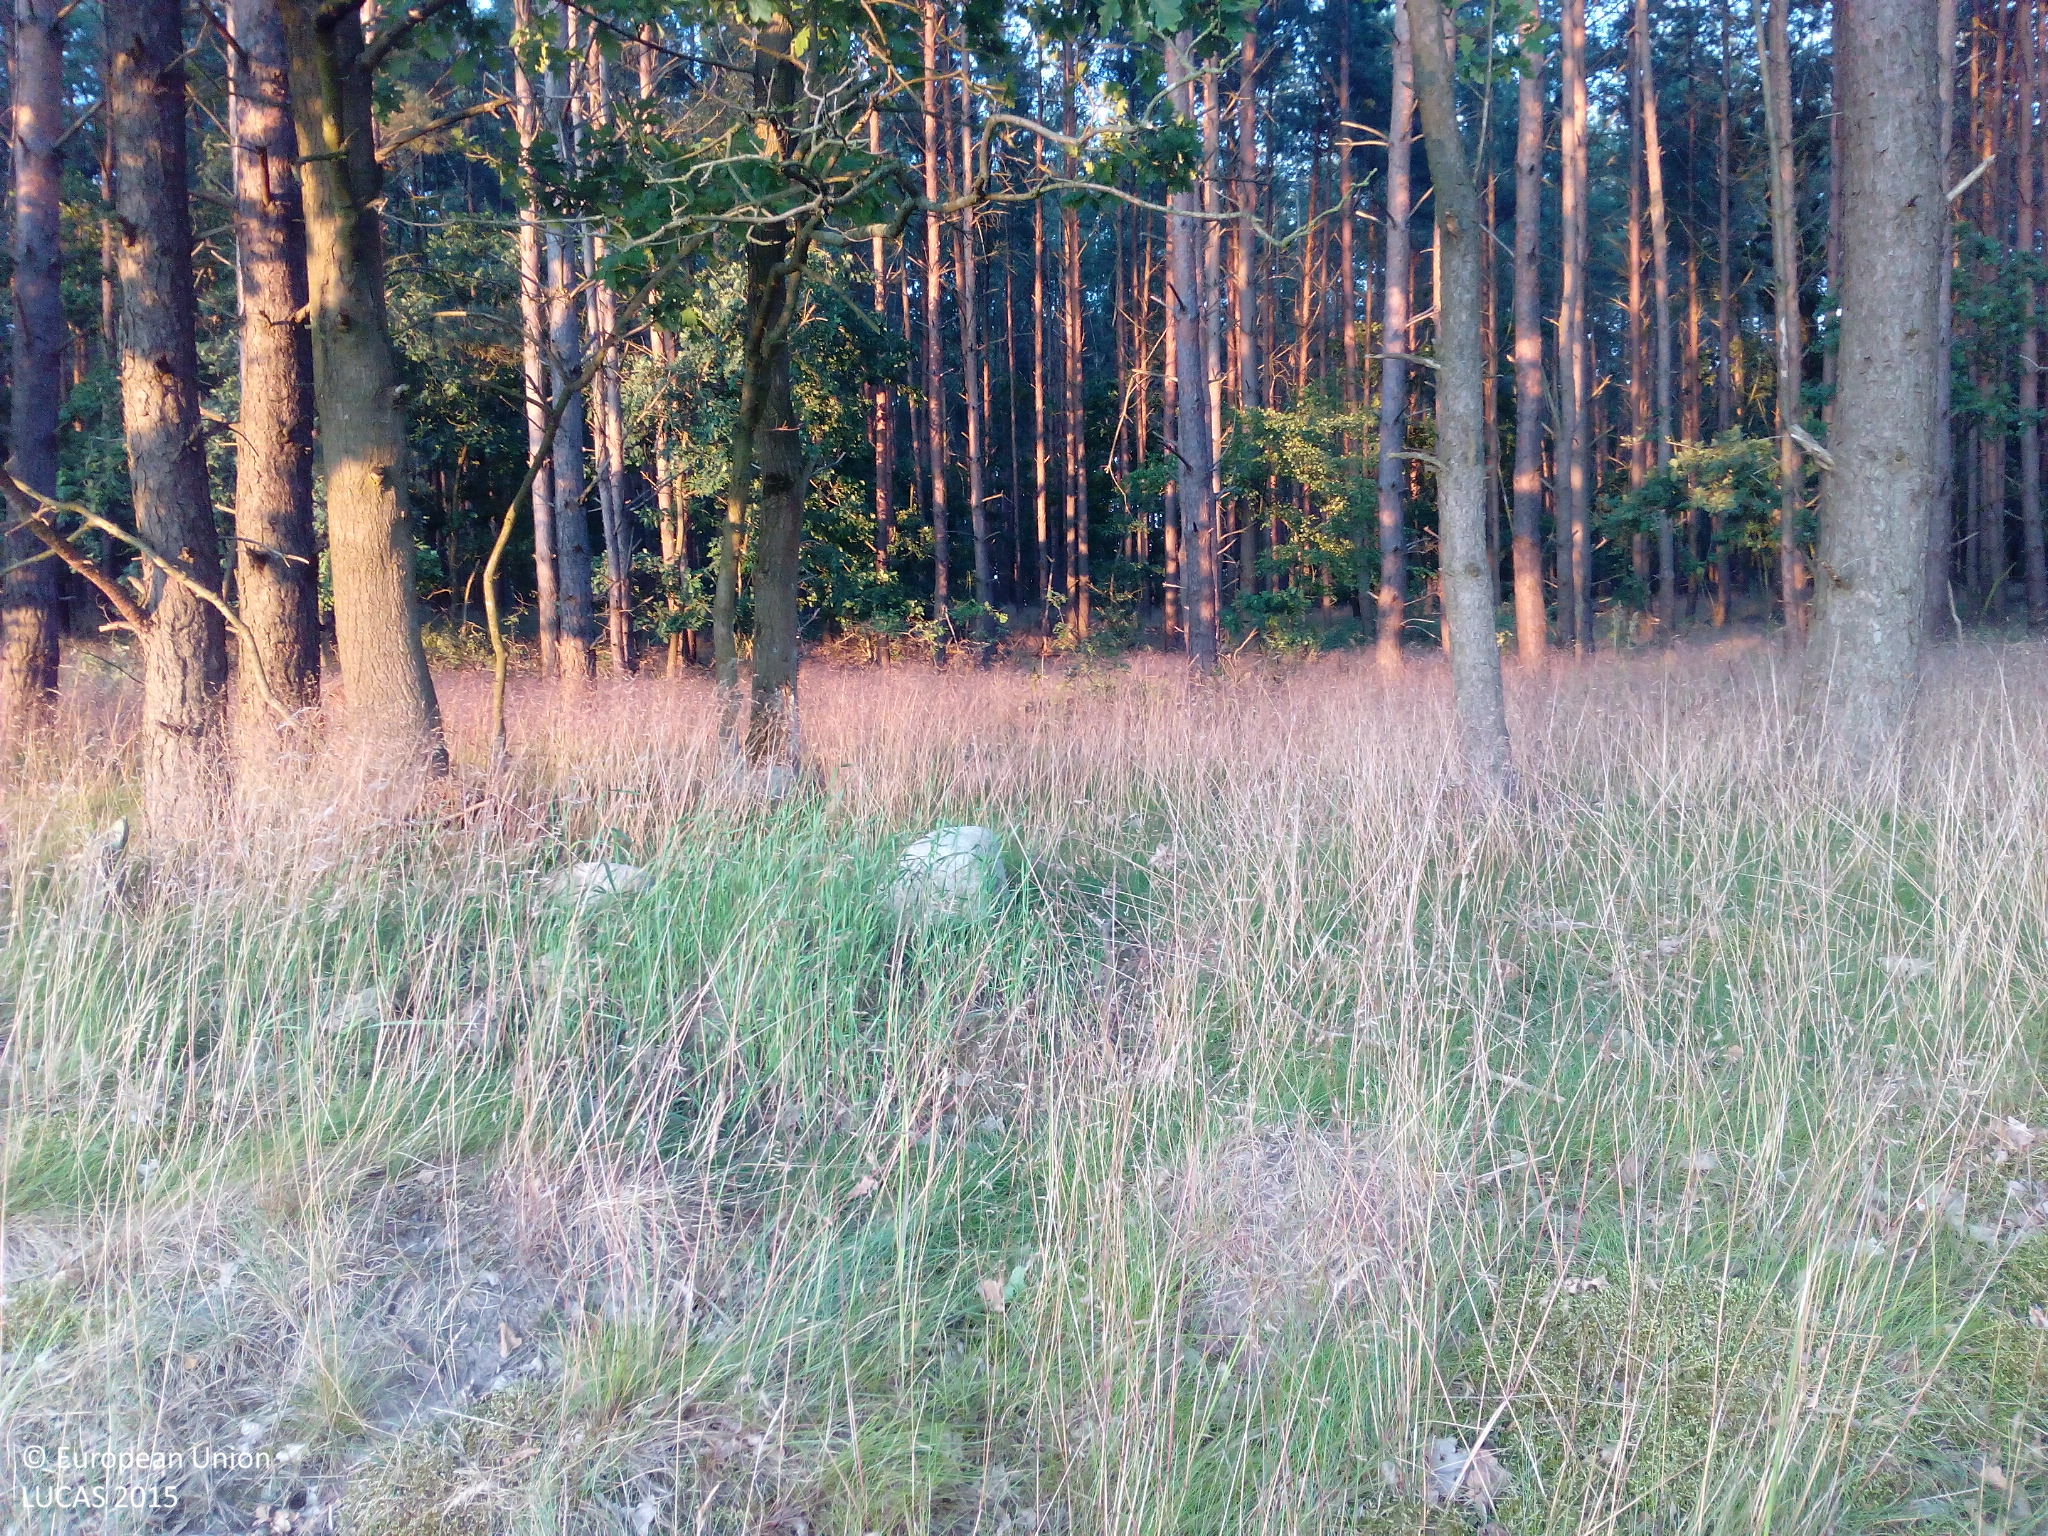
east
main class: Cropland
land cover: Rye
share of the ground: 50 - 75 %
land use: Agriculture (excluding fallow land and kitchen gardens)
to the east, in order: Rye; Grass margins; Pine dominated mixed woodland; Tracks; Pine dominated mixed woodland; Rye
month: July
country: DE
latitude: 53.5089
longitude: 14.2075
